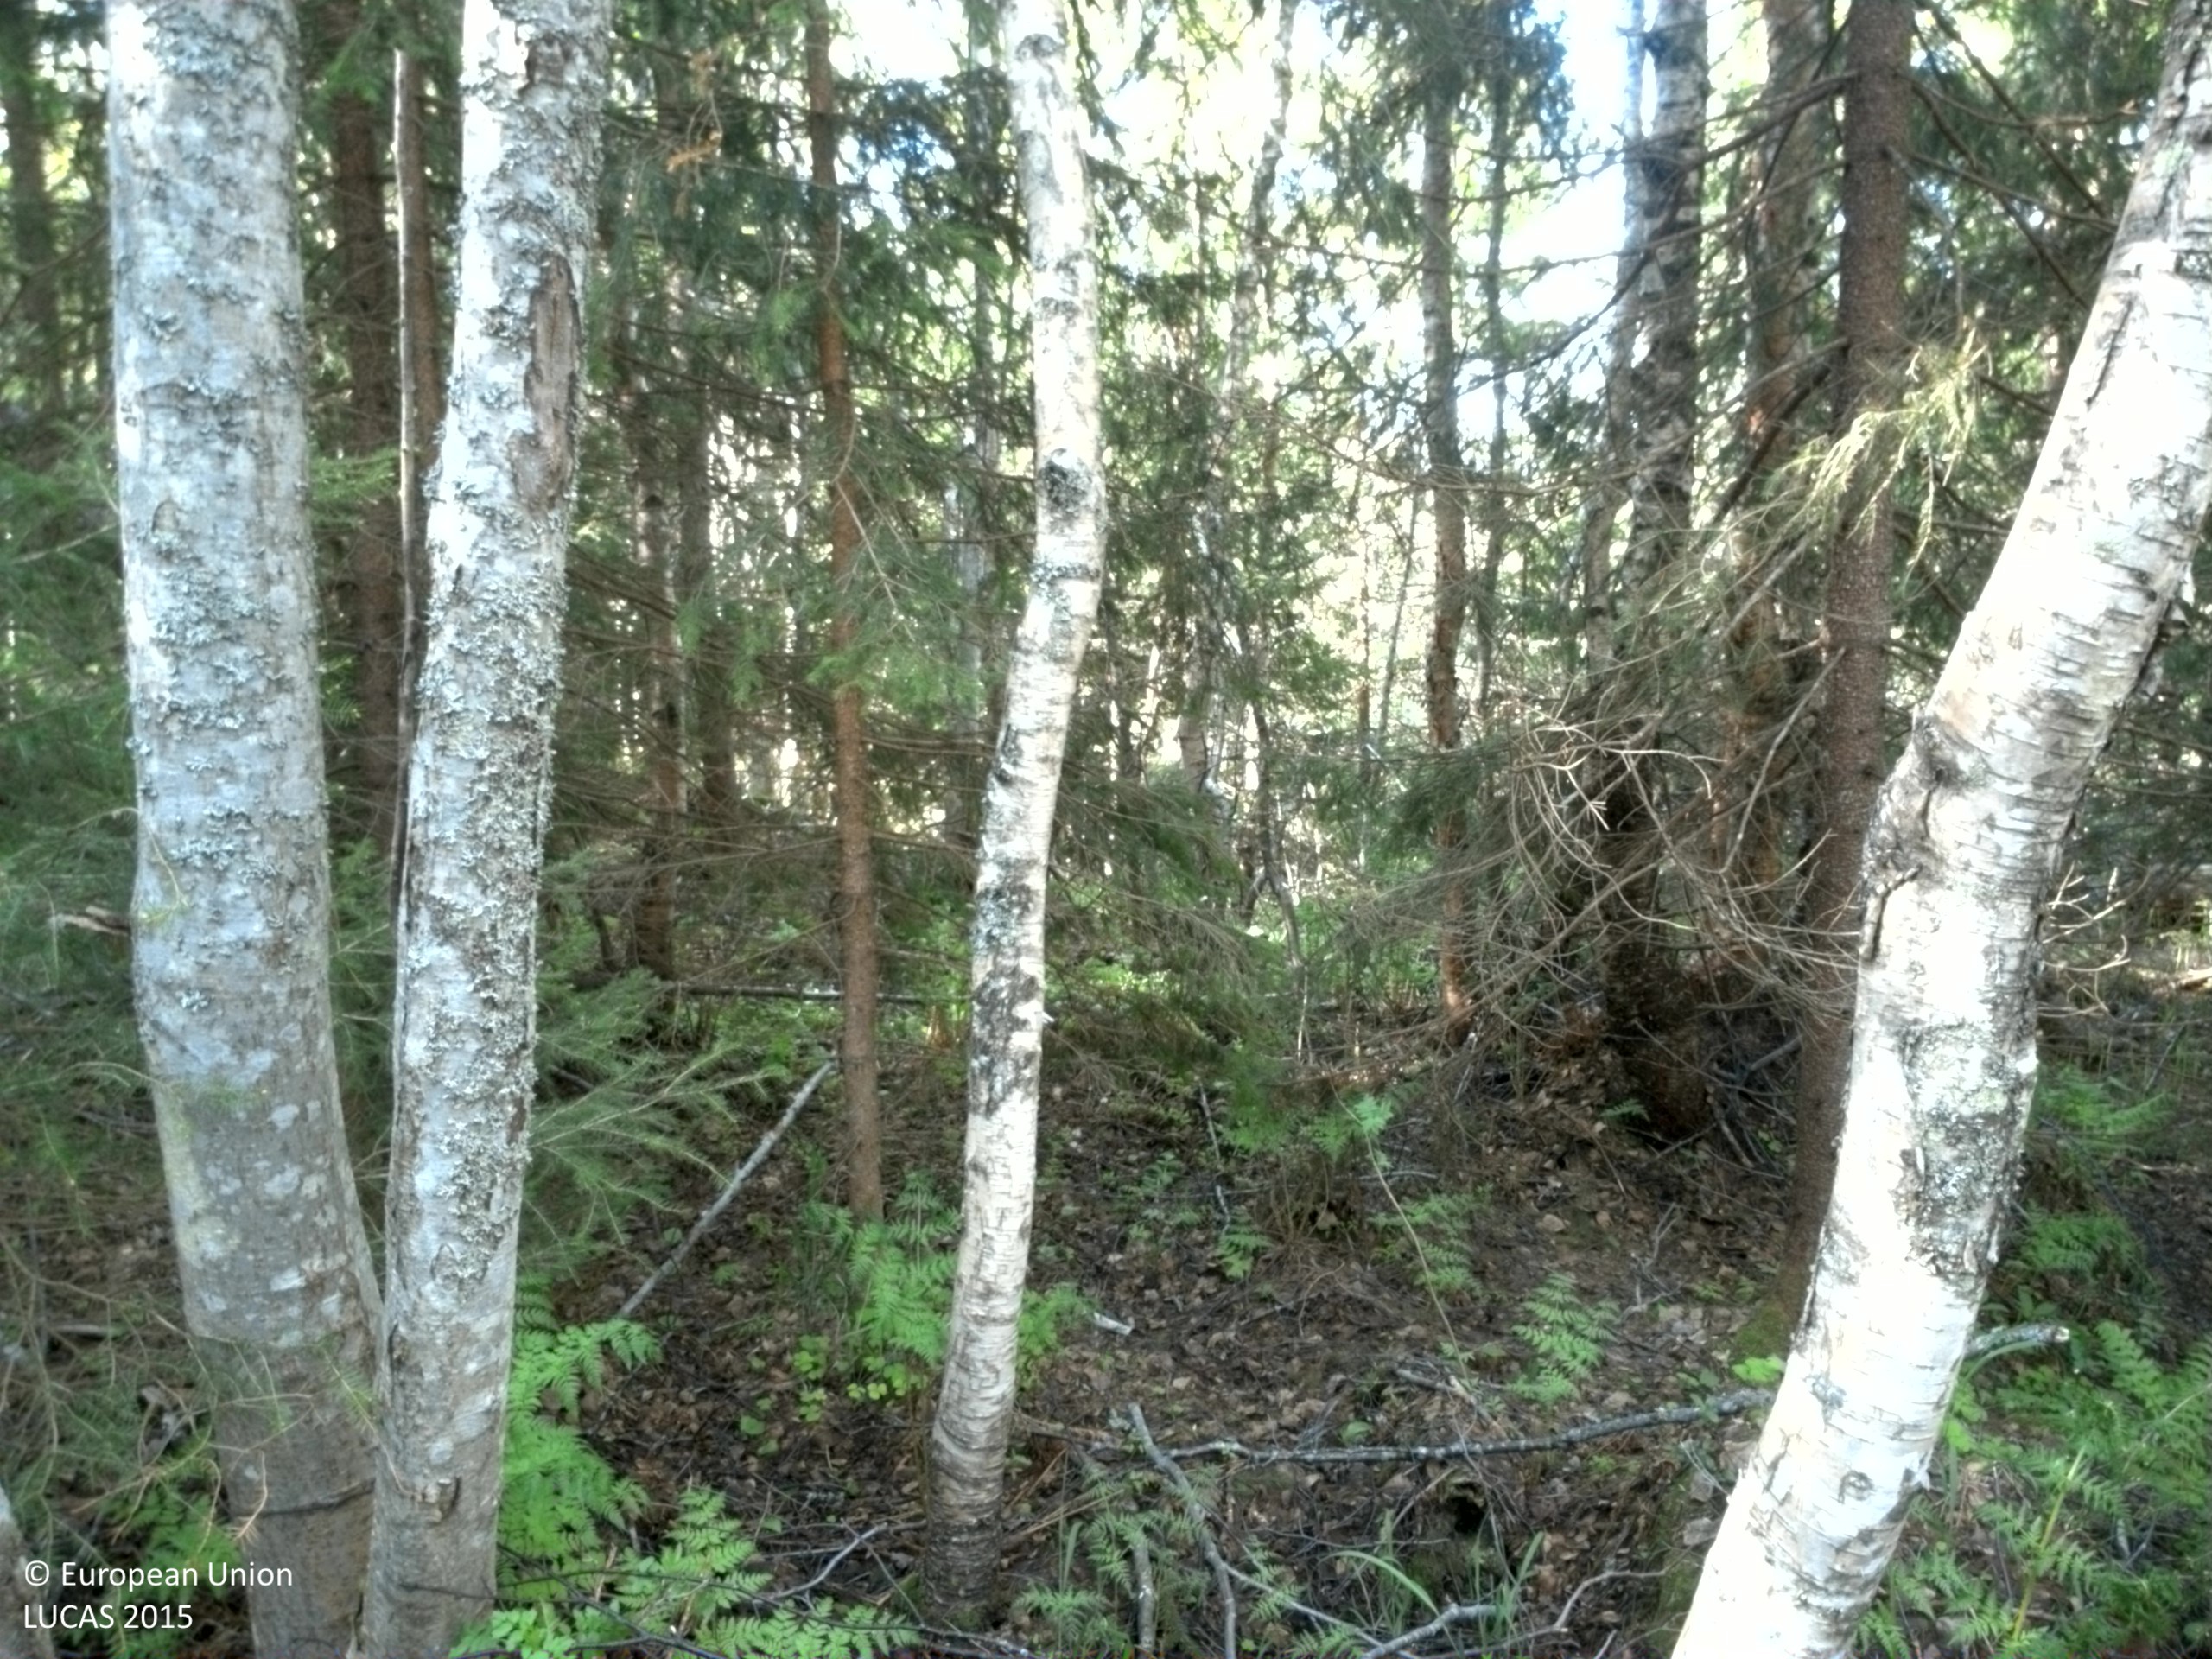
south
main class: Woodland
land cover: Other mixed woodland
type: boreal forest
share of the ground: > 75 %
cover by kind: broadleaved forest trees 60 %, coniferous forest trees 20 %, consolidated bare surface 20 %
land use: Forestry
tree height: > 5 m
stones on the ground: 25 - 50 %
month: May
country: SE
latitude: 62.8061
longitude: 18.1981
